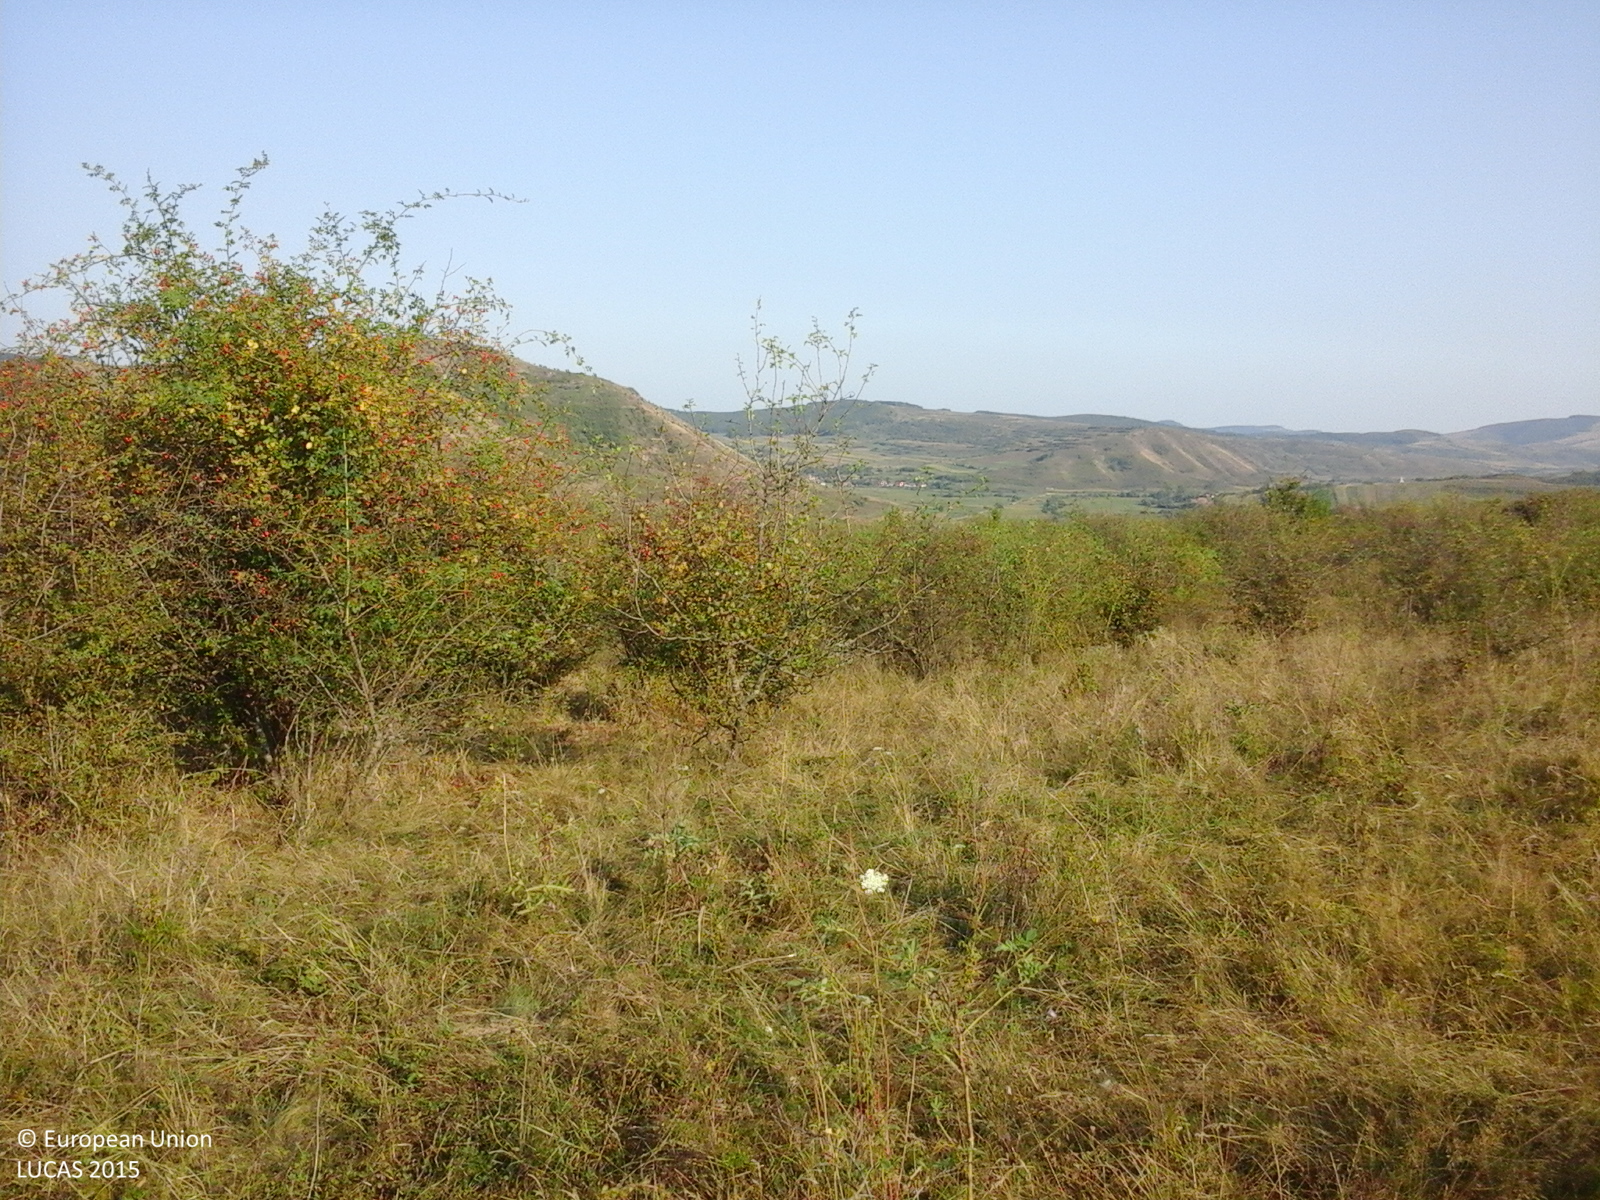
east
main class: Grassland
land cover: Grassland with sparse tree/shrub cover
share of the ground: > 75 %
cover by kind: herbaceous plants 85 %, shrubs 10 %, broadleaved forest trees 5 %
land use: Agriculture (excluding fallow land and kitchen gardens)
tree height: < 5 m
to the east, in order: Grassland with sparse tree/shrub cover; Shrubland with sparse tree cover
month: September
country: RO
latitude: 47.0594
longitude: 24.2115
